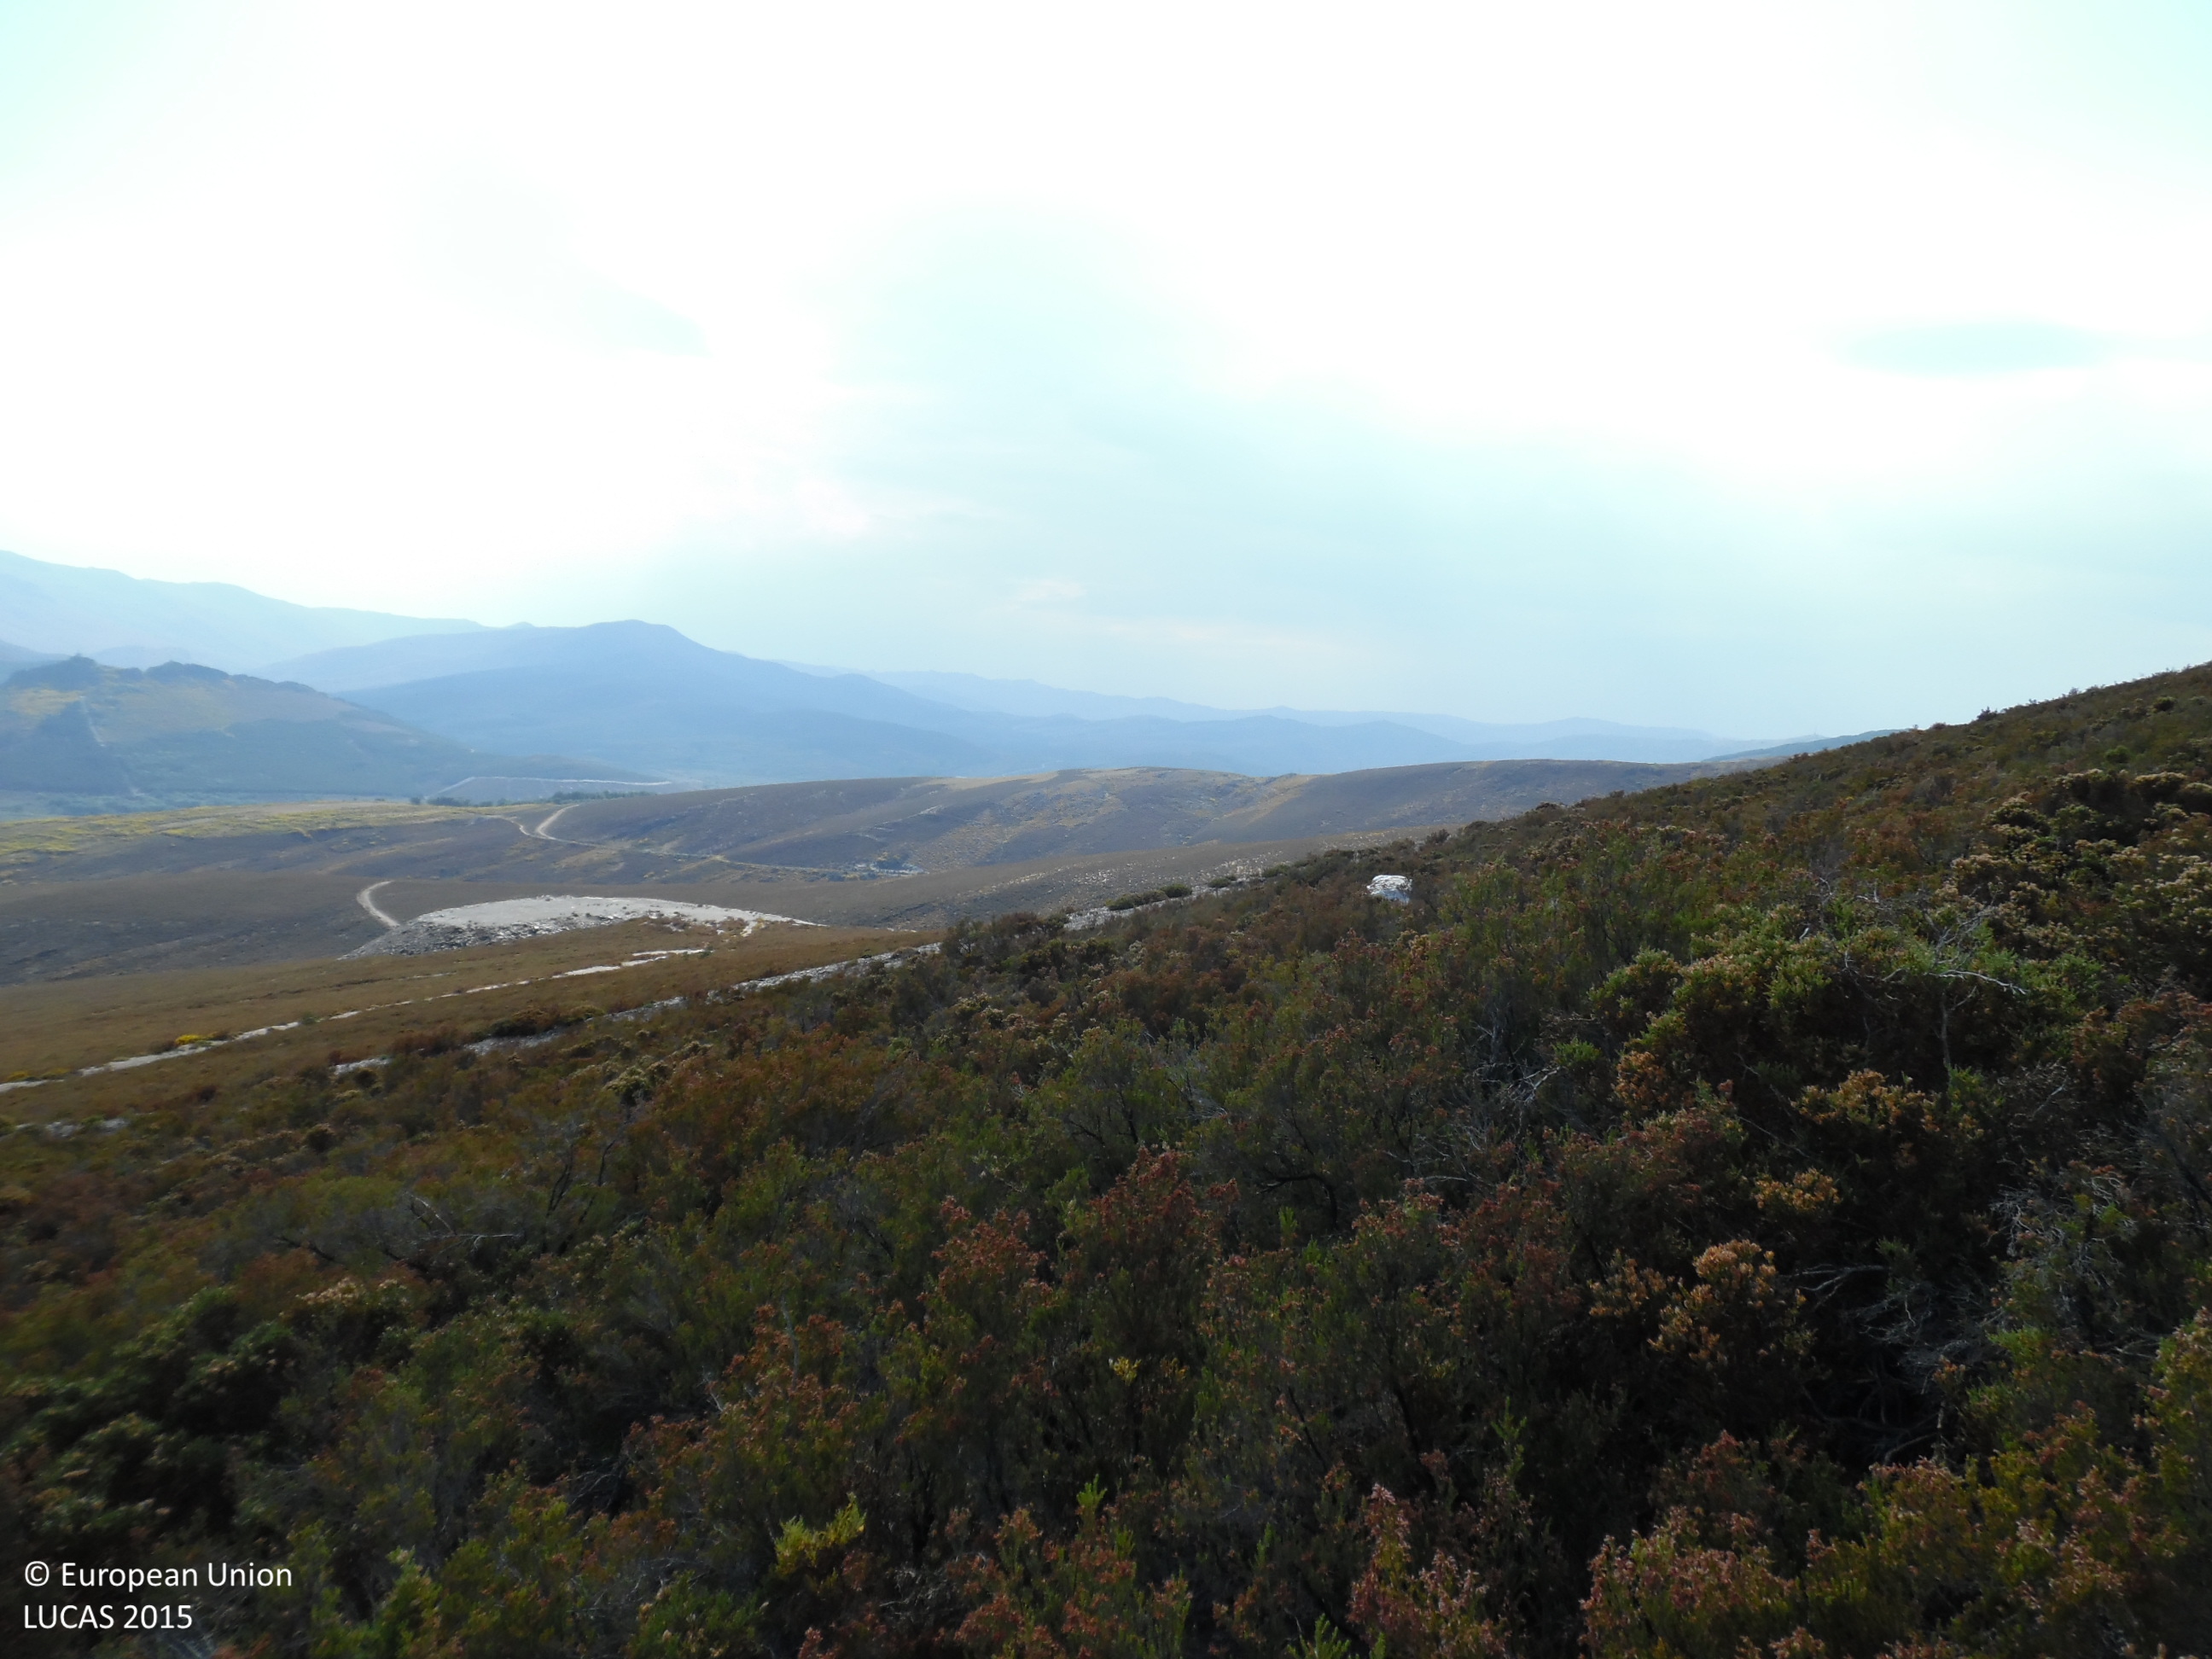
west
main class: Shrubland
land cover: Shrubland without tree cover
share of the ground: > 75 %
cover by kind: shrubs 90 %, unconsolidated bare surface 10 %
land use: Semi-natural and natural areas not in use
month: June
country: ES
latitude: 42.2642
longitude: -6.3922
